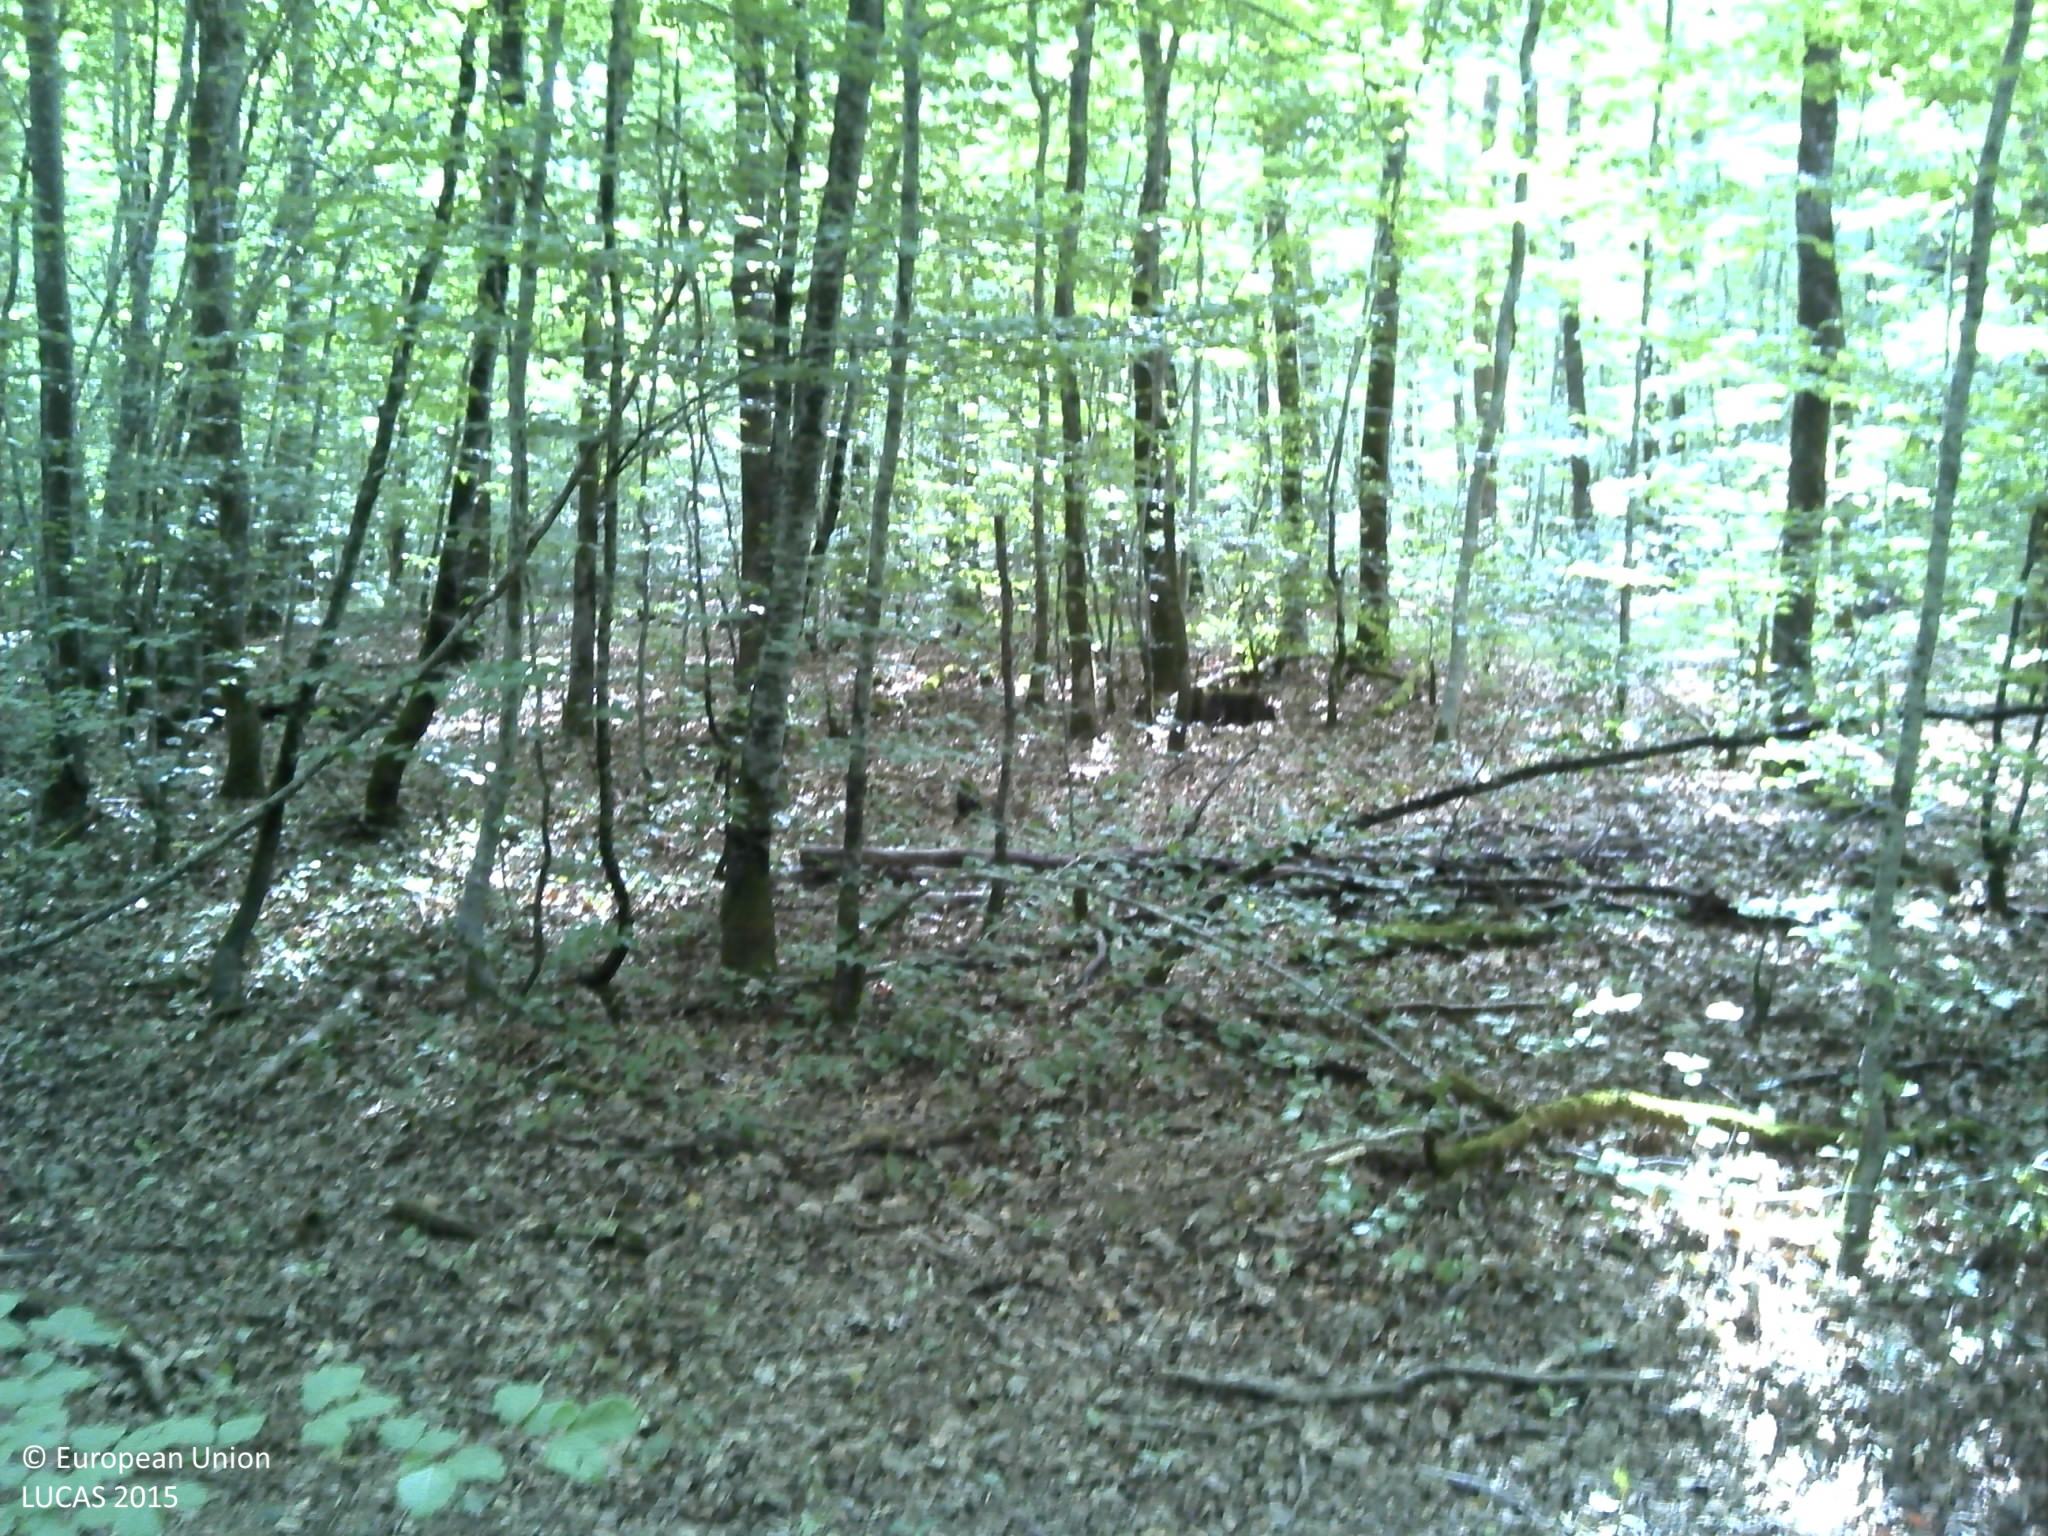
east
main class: Woodland
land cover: Broadleaved woodland
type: acidophilous oak and oak-birch forest
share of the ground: > 75 %
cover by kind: broadleaved forest trees 90 %, herbaceous plants 5 %, unconsolidated bare surface 5 %
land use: Forestry
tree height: > 5 m
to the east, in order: Broadleaved woodland
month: July
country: FR
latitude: 48.0076
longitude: 6.0194
